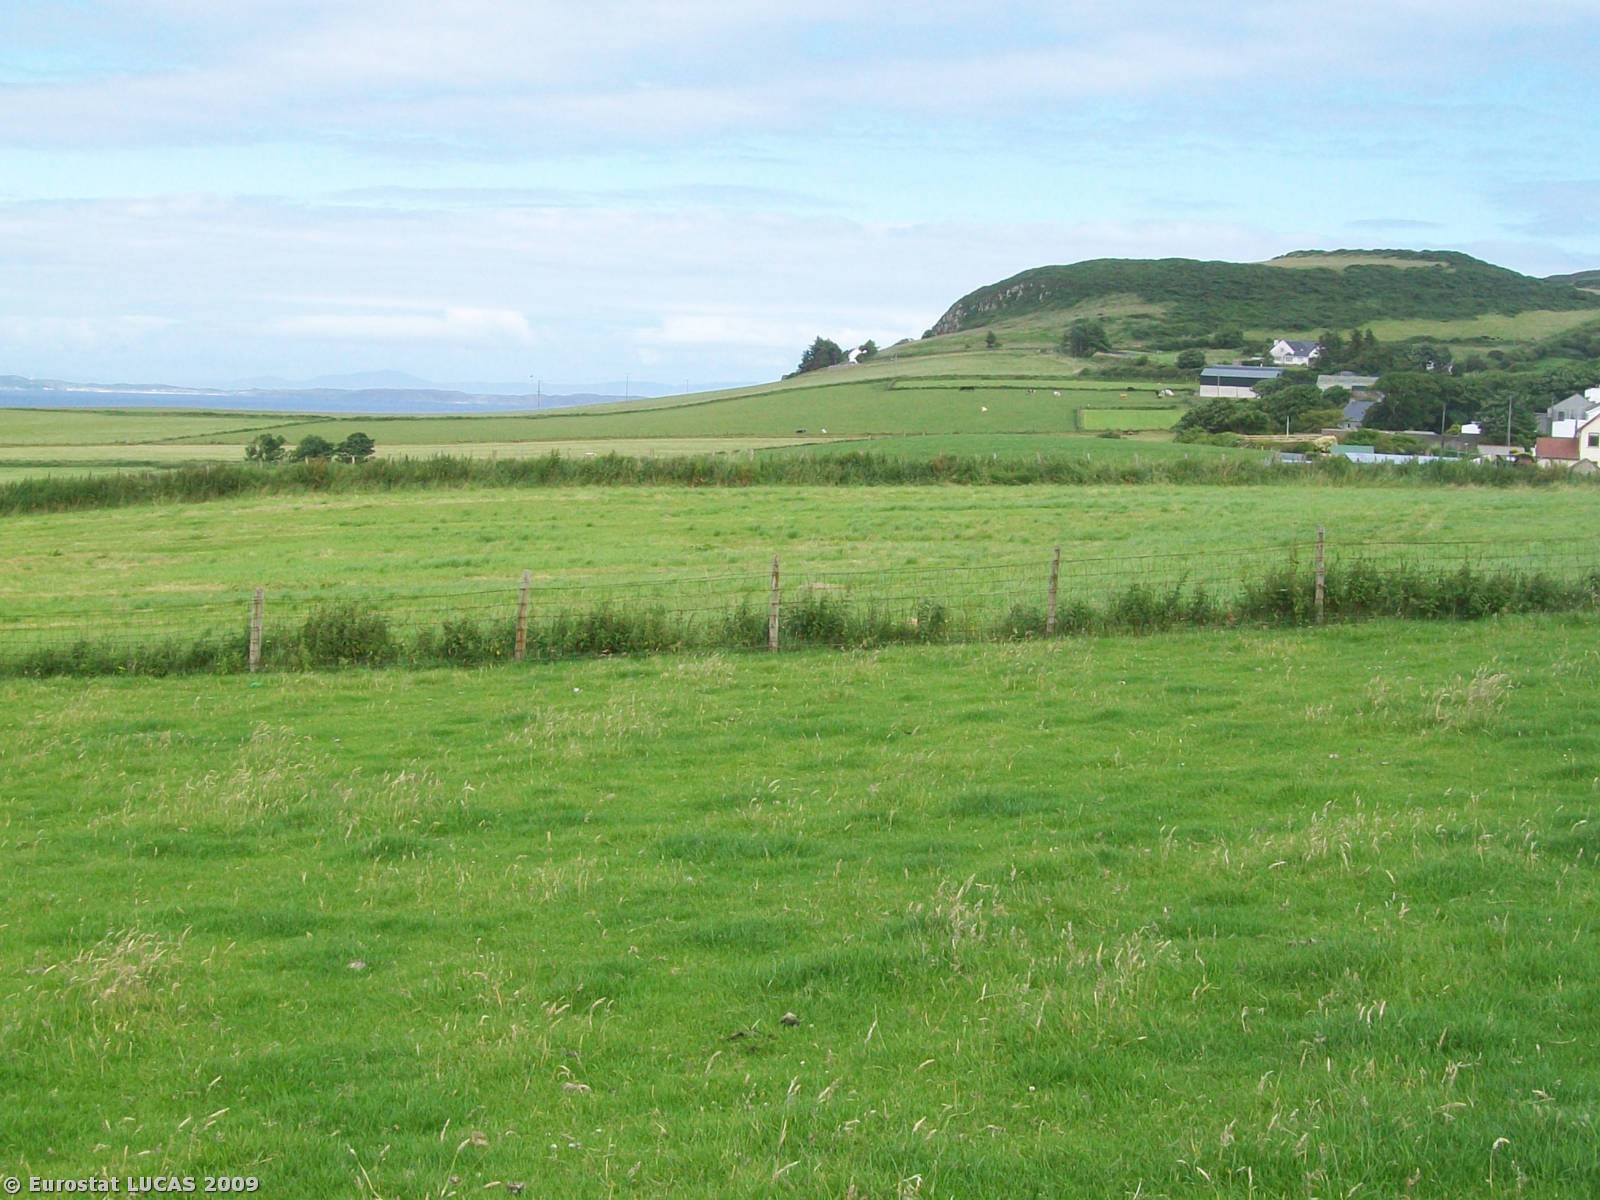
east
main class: Grassland
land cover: Grassland without tree/shrub cover
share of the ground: > 75 %
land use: Agriculture (excluding fallow land and kitchen gardens)
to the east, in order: Grassland without tree/shrub cover; Fences; Grassland without tree/shrub cover; Fences; Grassland without tree/shrub cover; Fences; Grassland without tree/shrub cover; Fences; Grassland with sparse tree/shrub cover; Fences; Paved roads, cycling and walking lanes; Artificial constructions in urban areas
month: July
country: GB
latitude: 55.2369
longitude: -6.3625
